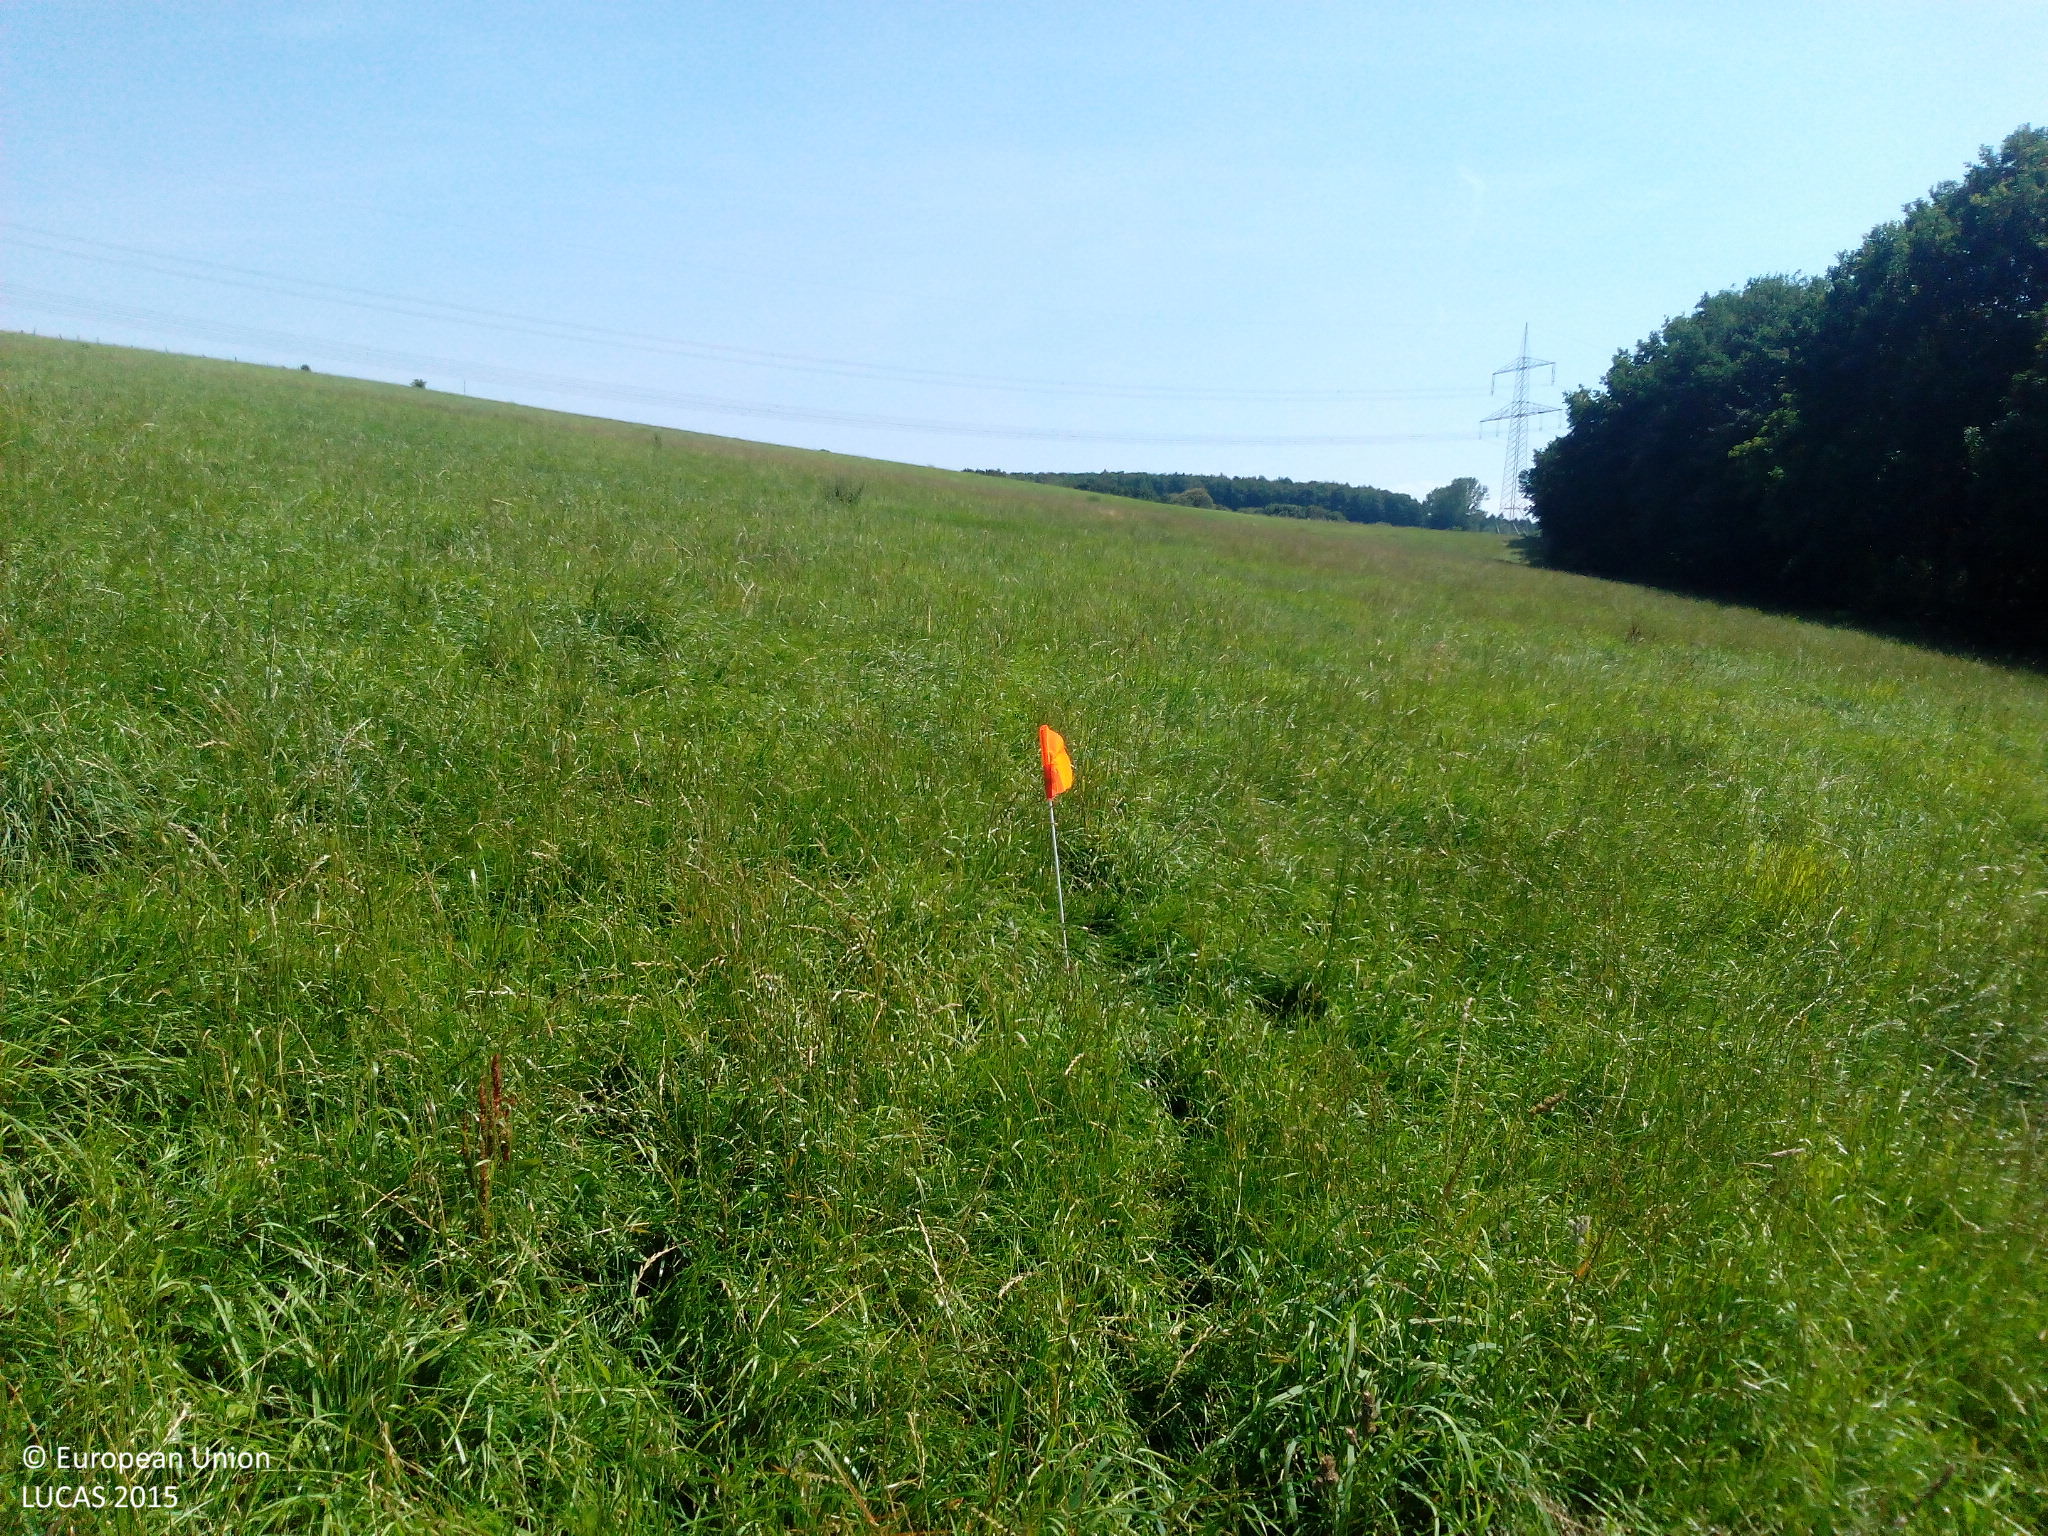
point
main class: Grassland
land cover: Grassland without tree/shrub cover
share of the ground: > 75 %
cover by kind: herbaceous plants 100 %
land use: Agriculture (excluding fallow land and kitchen gardens)
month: August
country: DE
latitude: 51.7279
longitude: 9.2329
